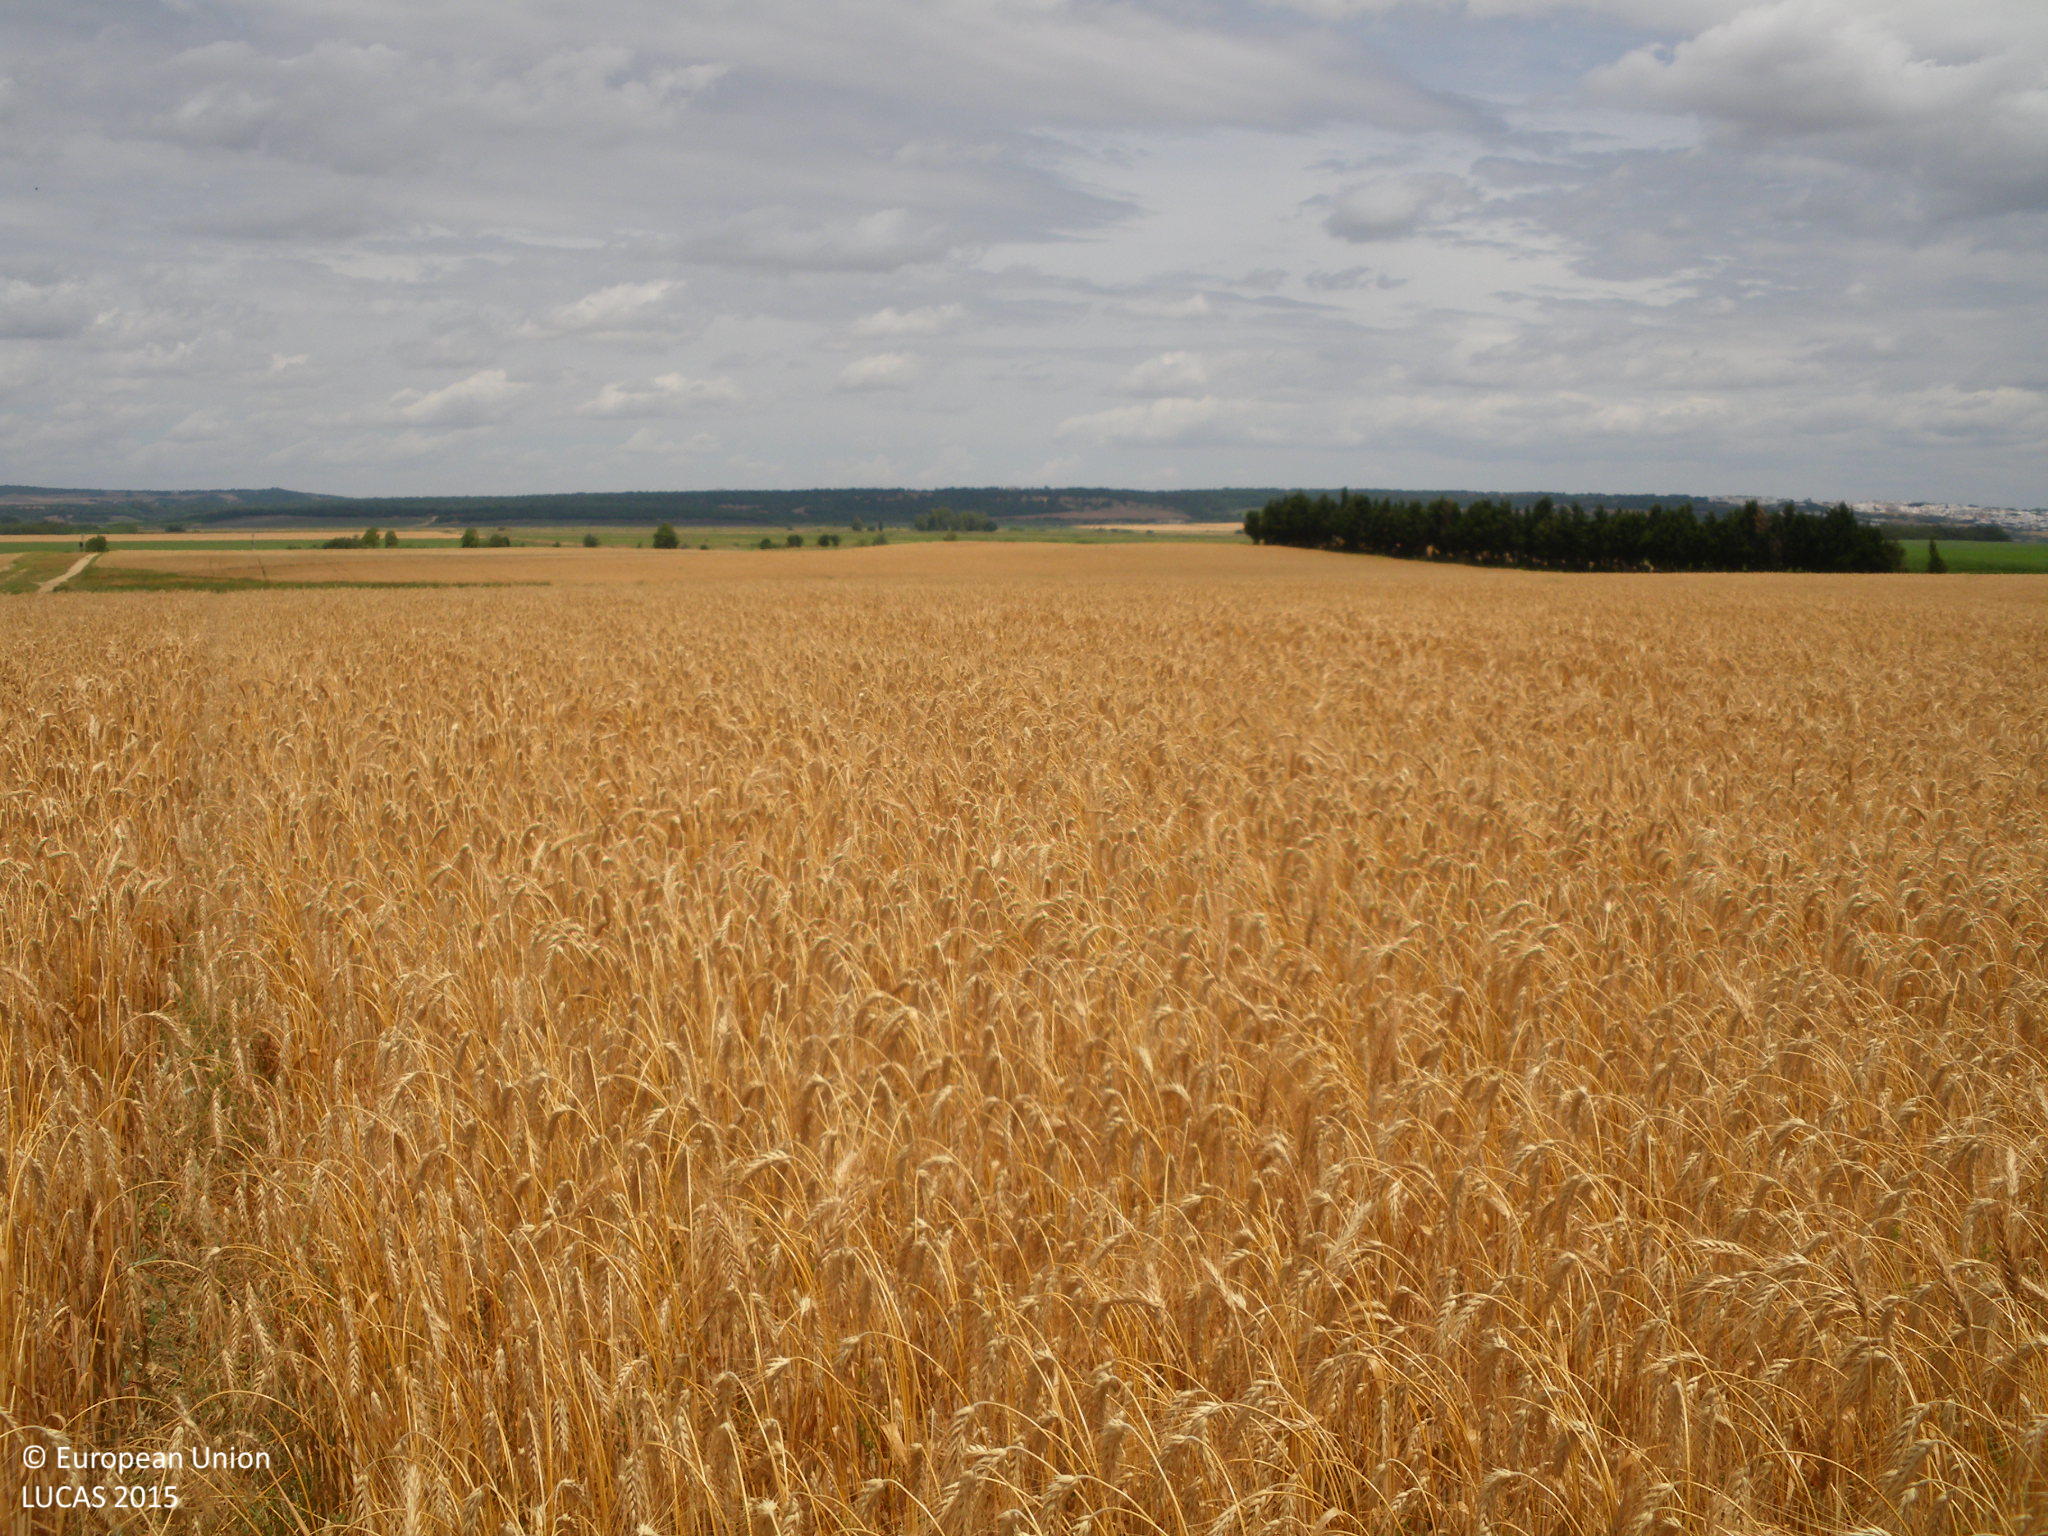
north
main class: Cropland
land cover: Durum wheat
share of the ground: > 75 %
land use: Agriculture (excluding fallow land and kitchen gardens)
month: June
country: ES
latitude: 36.2850
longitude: -5.8203
